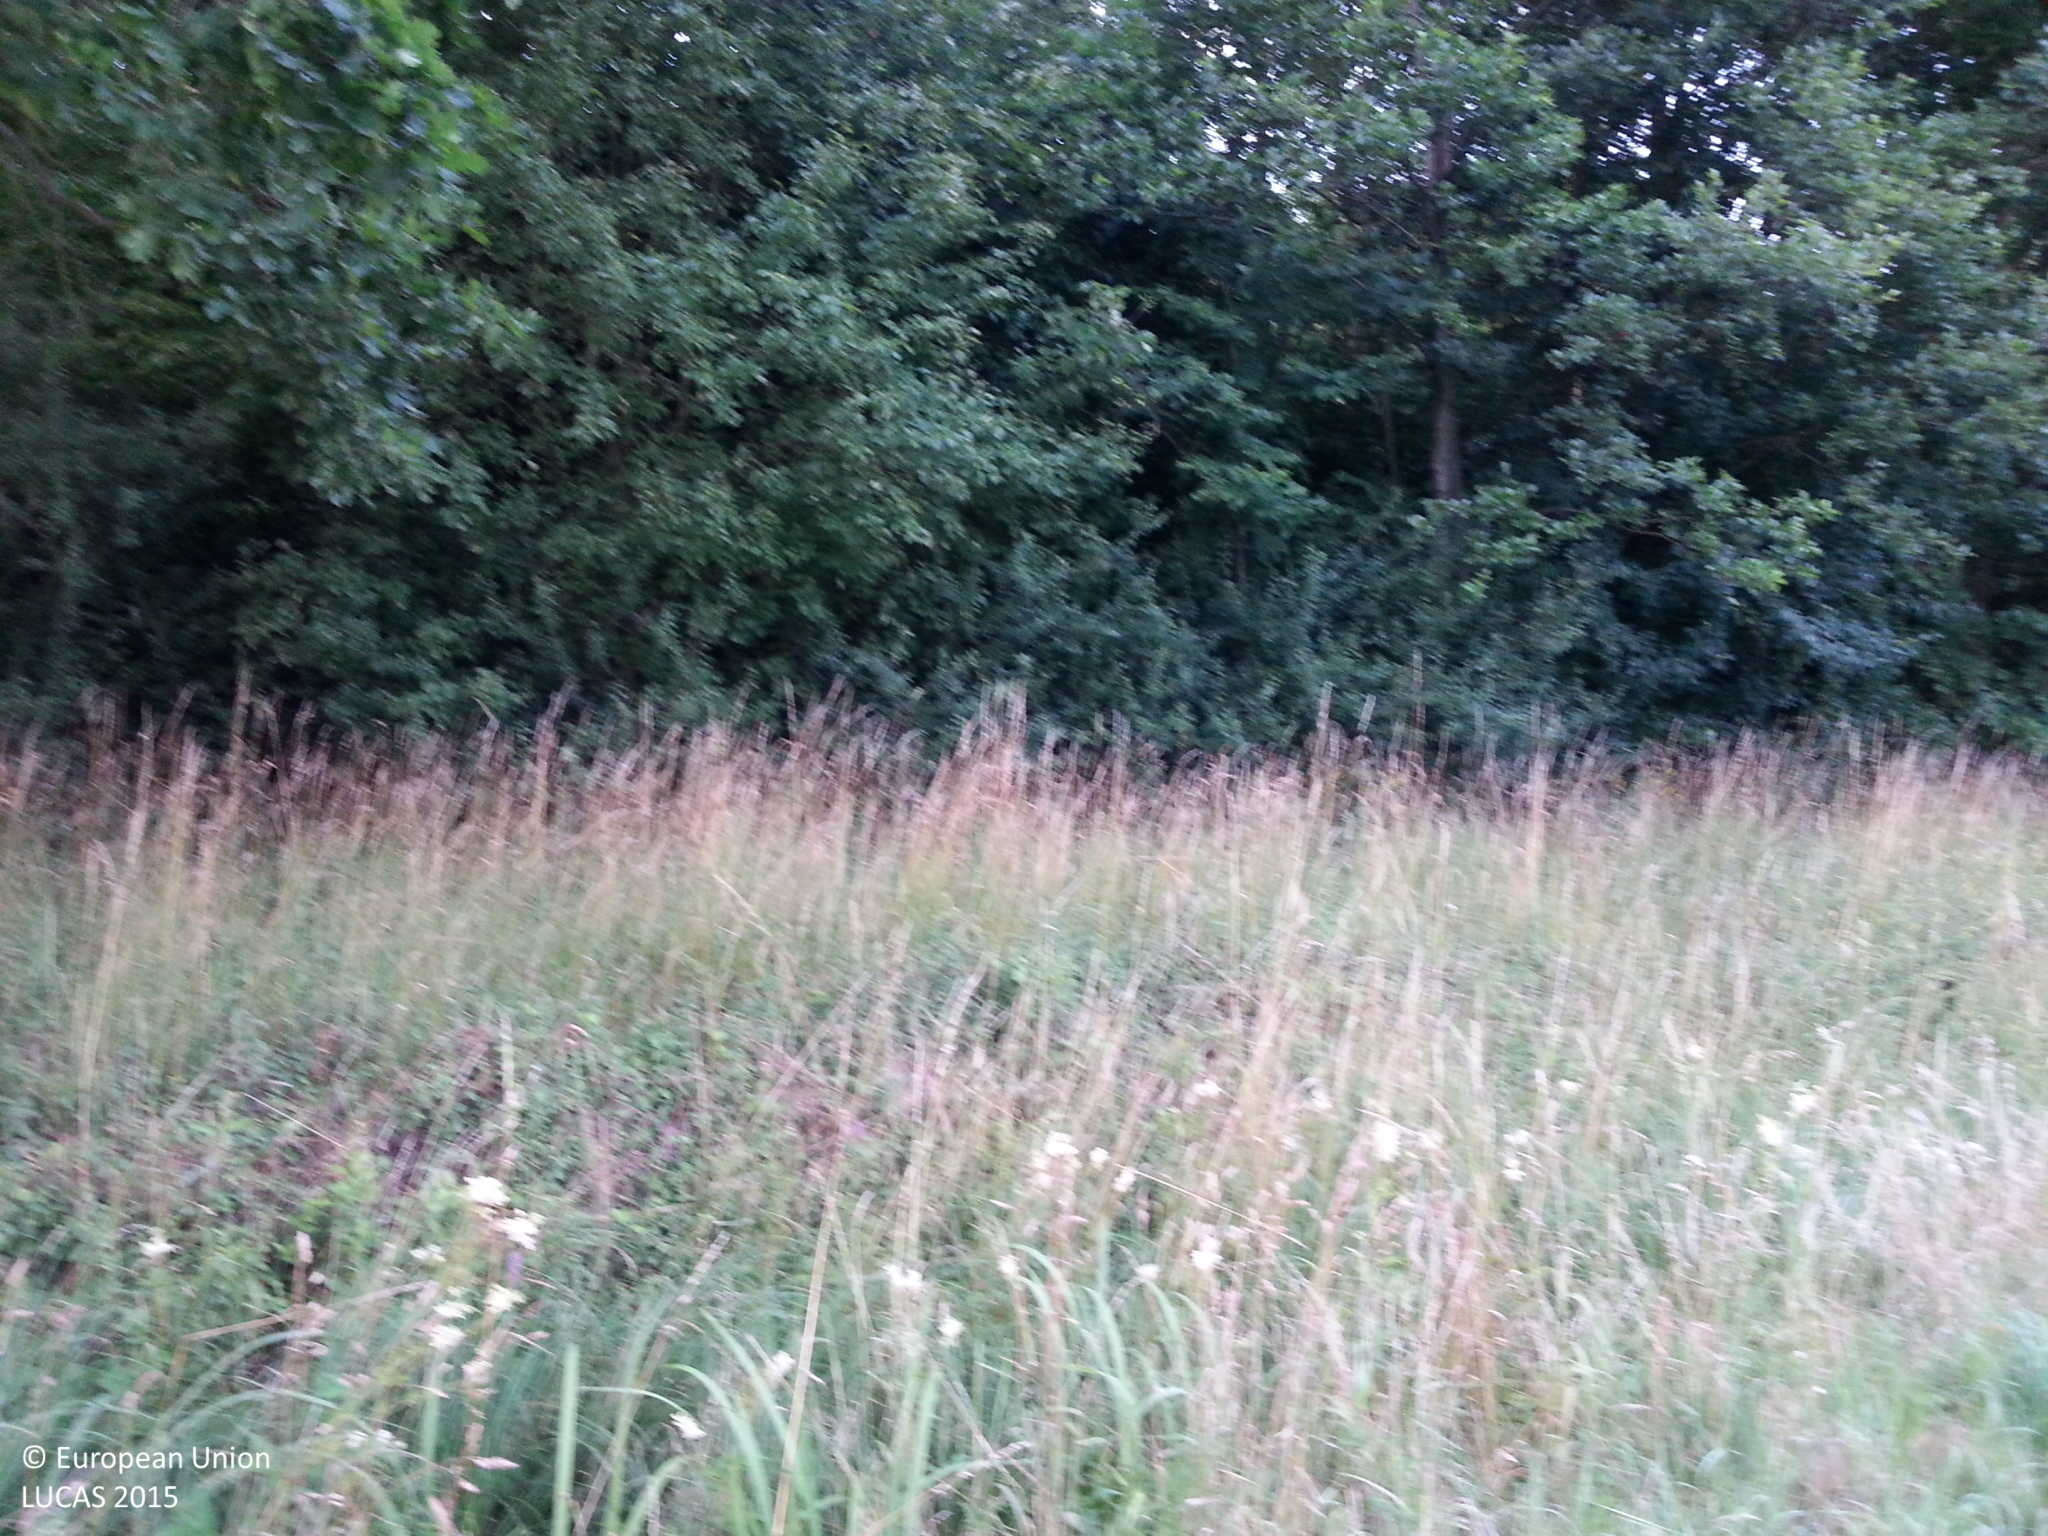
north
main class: Woodland
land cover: Broadleaved woodland
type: beech forest
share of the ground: > 75 %
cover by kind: broadleaved forest trees 80 %, herbaceous plants 20 %
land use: Forestry
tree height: > 5 m
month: July
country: DE
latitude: 53.0334
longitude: 11.4758
